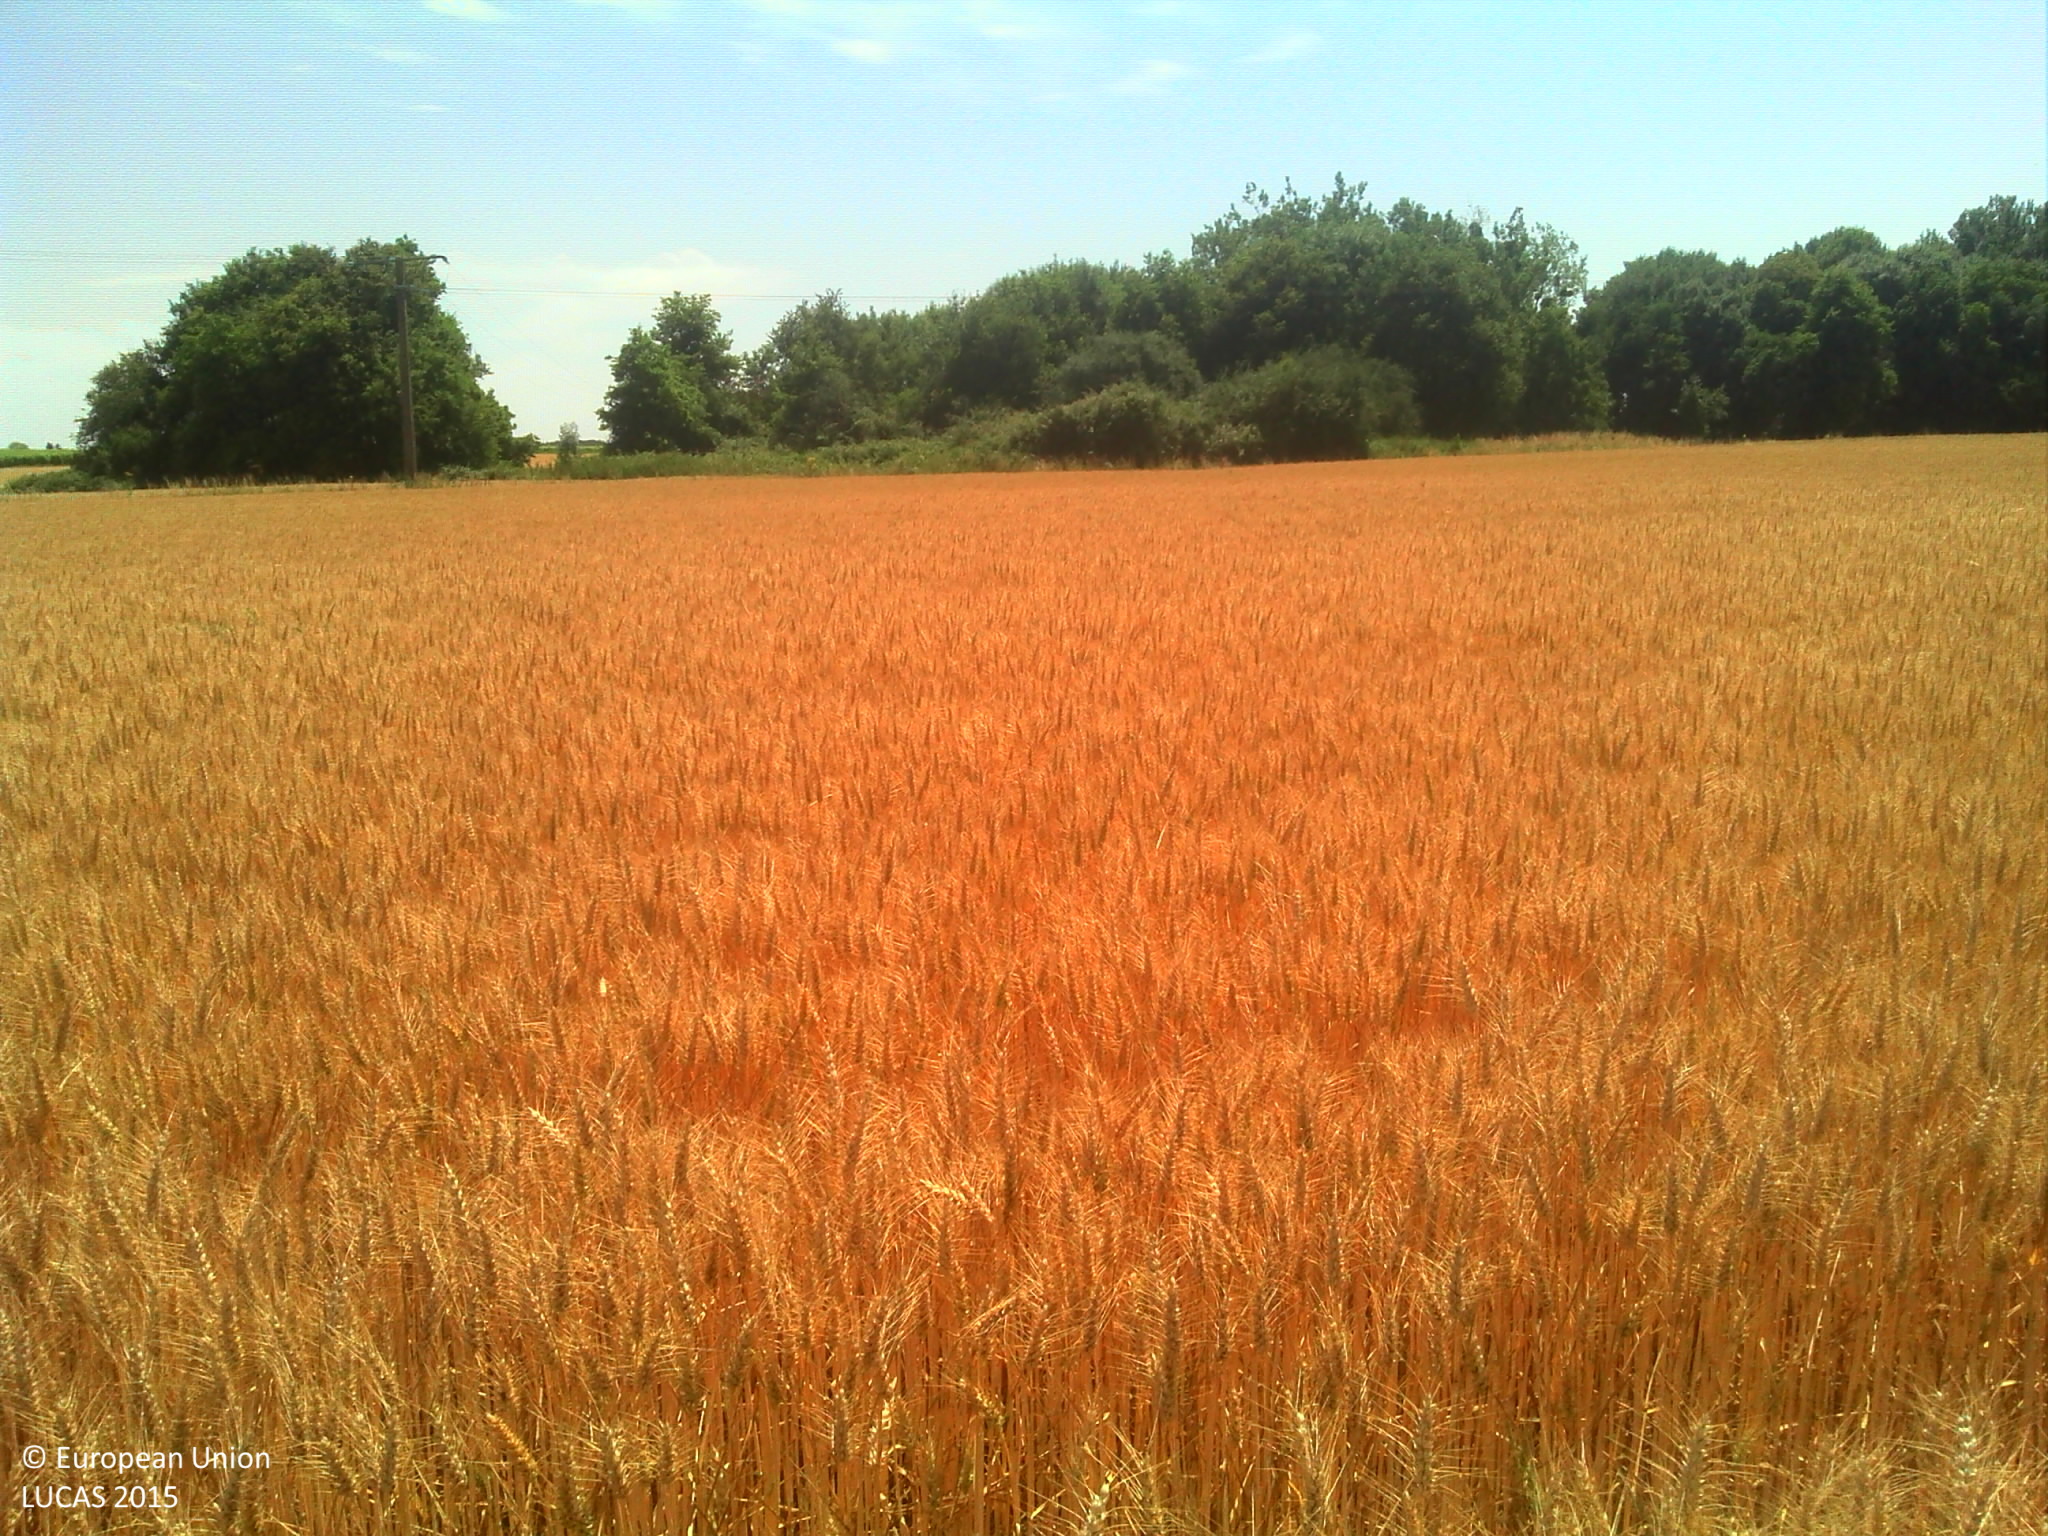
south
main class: Cropland
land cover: Durum wheat
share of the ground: > 75 %
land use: Agriculture (excluding fallow land and kitchen gardens)
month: June
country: FR
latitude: 47.3952
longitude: 1.3605
